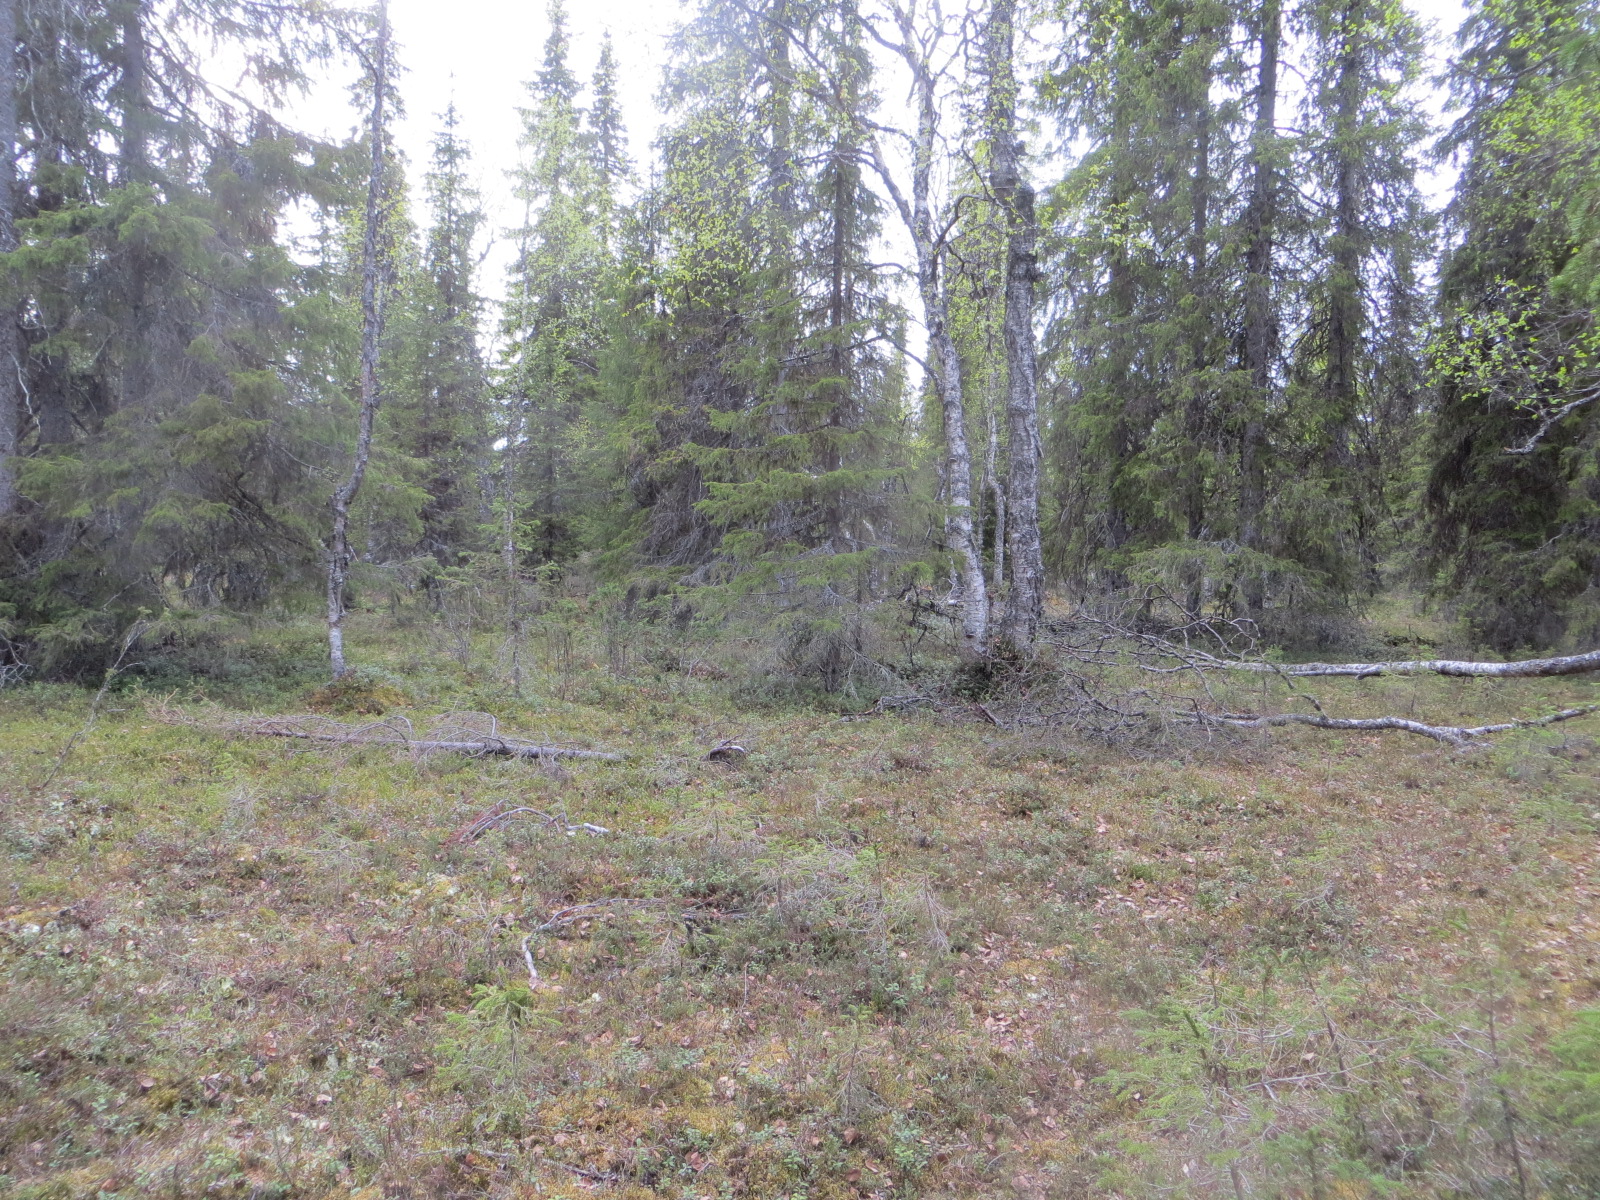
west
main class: Woodland
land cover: Spruce dominated mixed woodland
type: boreal forest
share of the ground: 50 - 75 %
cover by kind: coniferous forest trees 50 %, shrubs 25 %, broadleaved forest trees 20 %, lichens and mosses 5 %
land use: Semi-natural and natural areas not in use
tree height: > 5 m
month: June
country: FI
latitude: 67.9613
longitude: 26.1758
